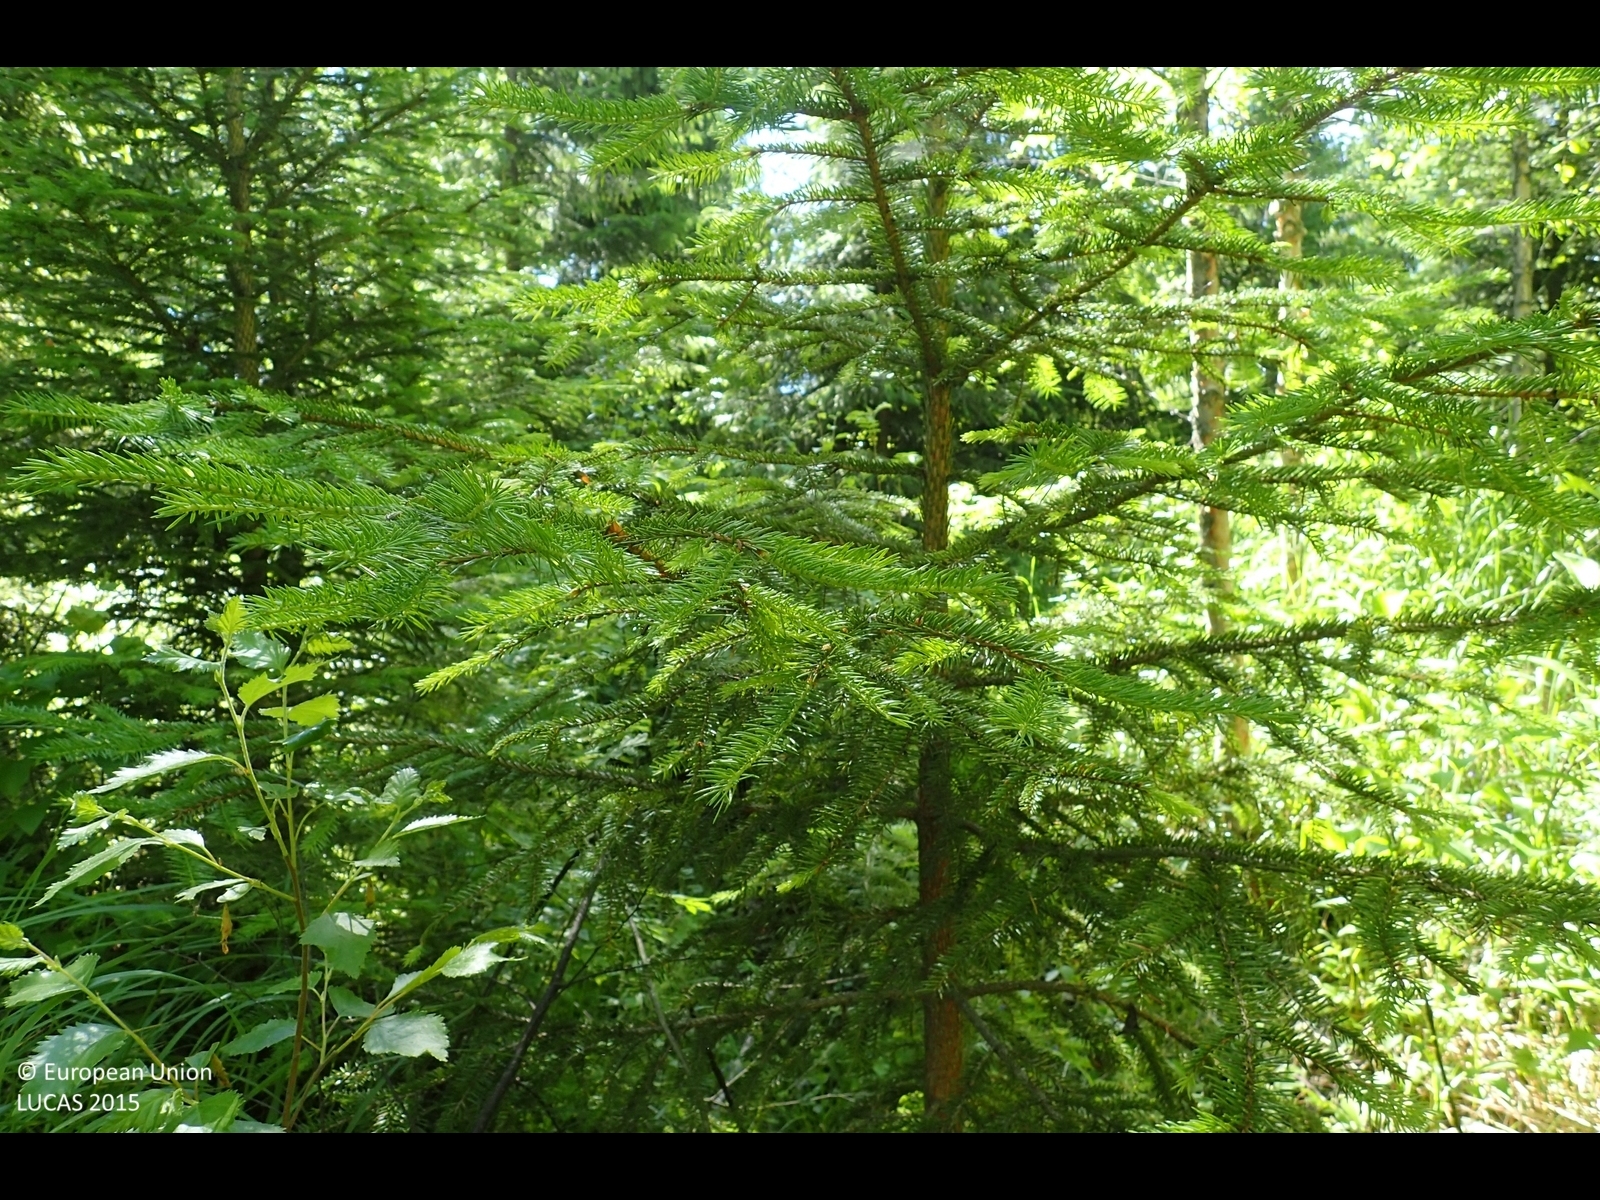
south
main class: Woodland
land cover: Broadleaved woodland
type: boreal forest
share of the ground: > 75 %
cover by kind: broadleaved forest trees 60 %, herbaceous plants 25 %, coniferous forest trees 15 %
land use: Forestry
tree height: > 5 m
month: July
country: FI
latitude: 62.4888
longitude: 21.6298
